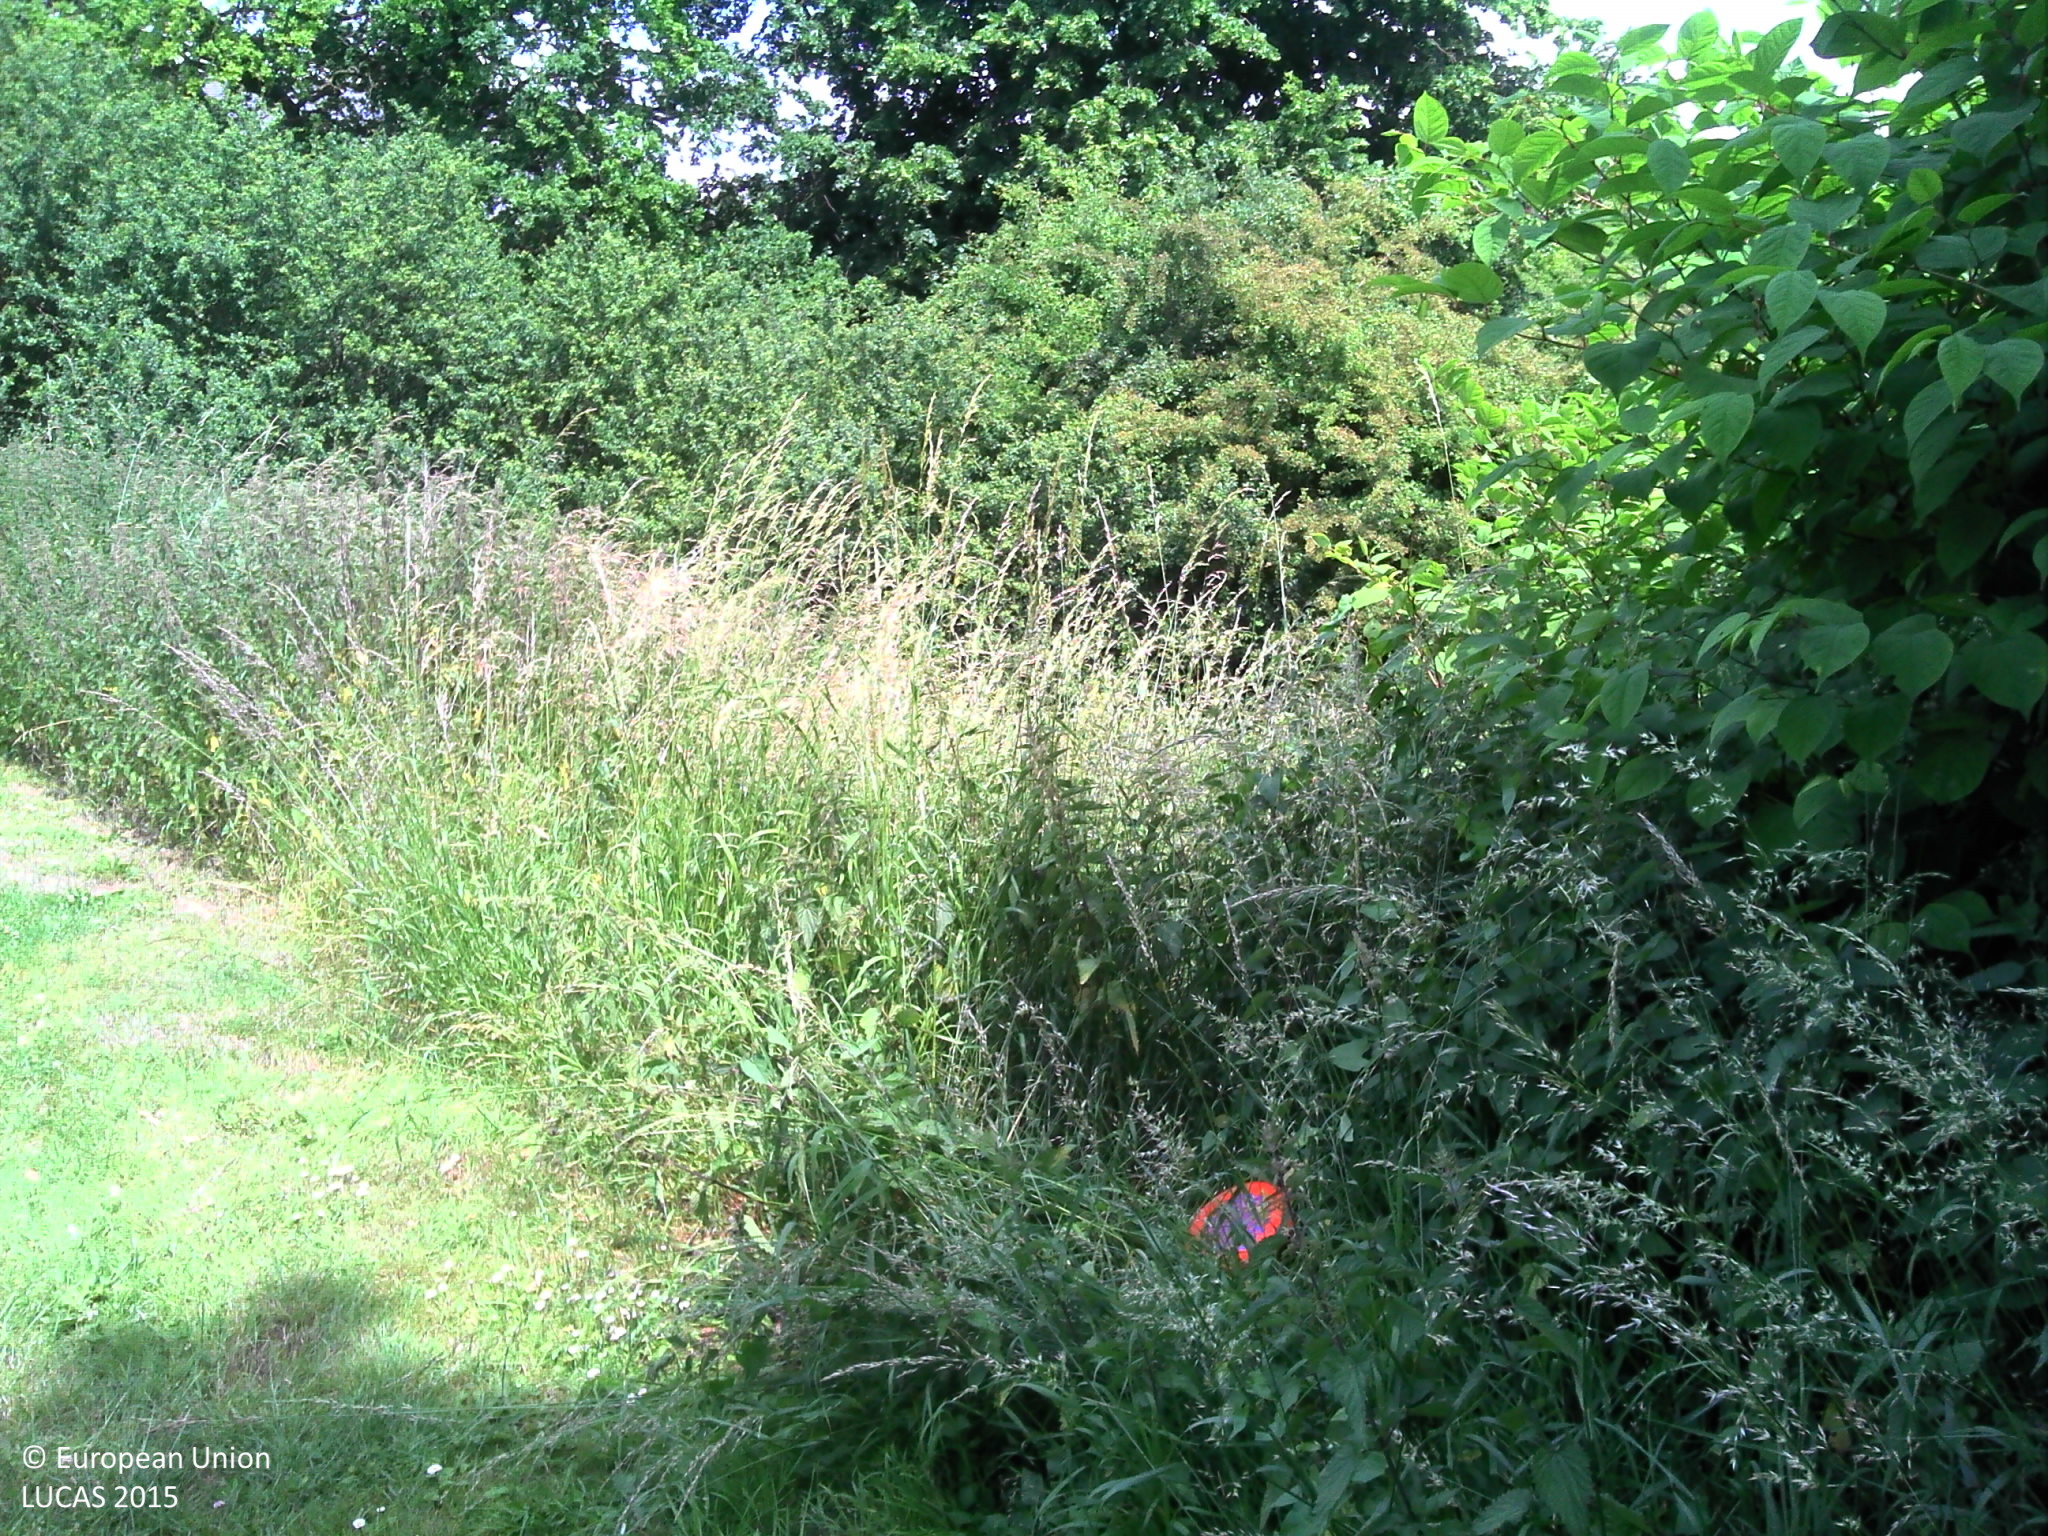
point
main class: Grassland
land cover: Grassland with sparse tree/shrub cover
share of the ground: > 75 %
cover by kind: herbaceous plants 85 %, shrubs 10 %, broadleaved forest trees 5 %
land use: Sport
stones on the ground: < 10 %
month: June
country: BE
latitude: 50.4837
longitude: 4.8809
